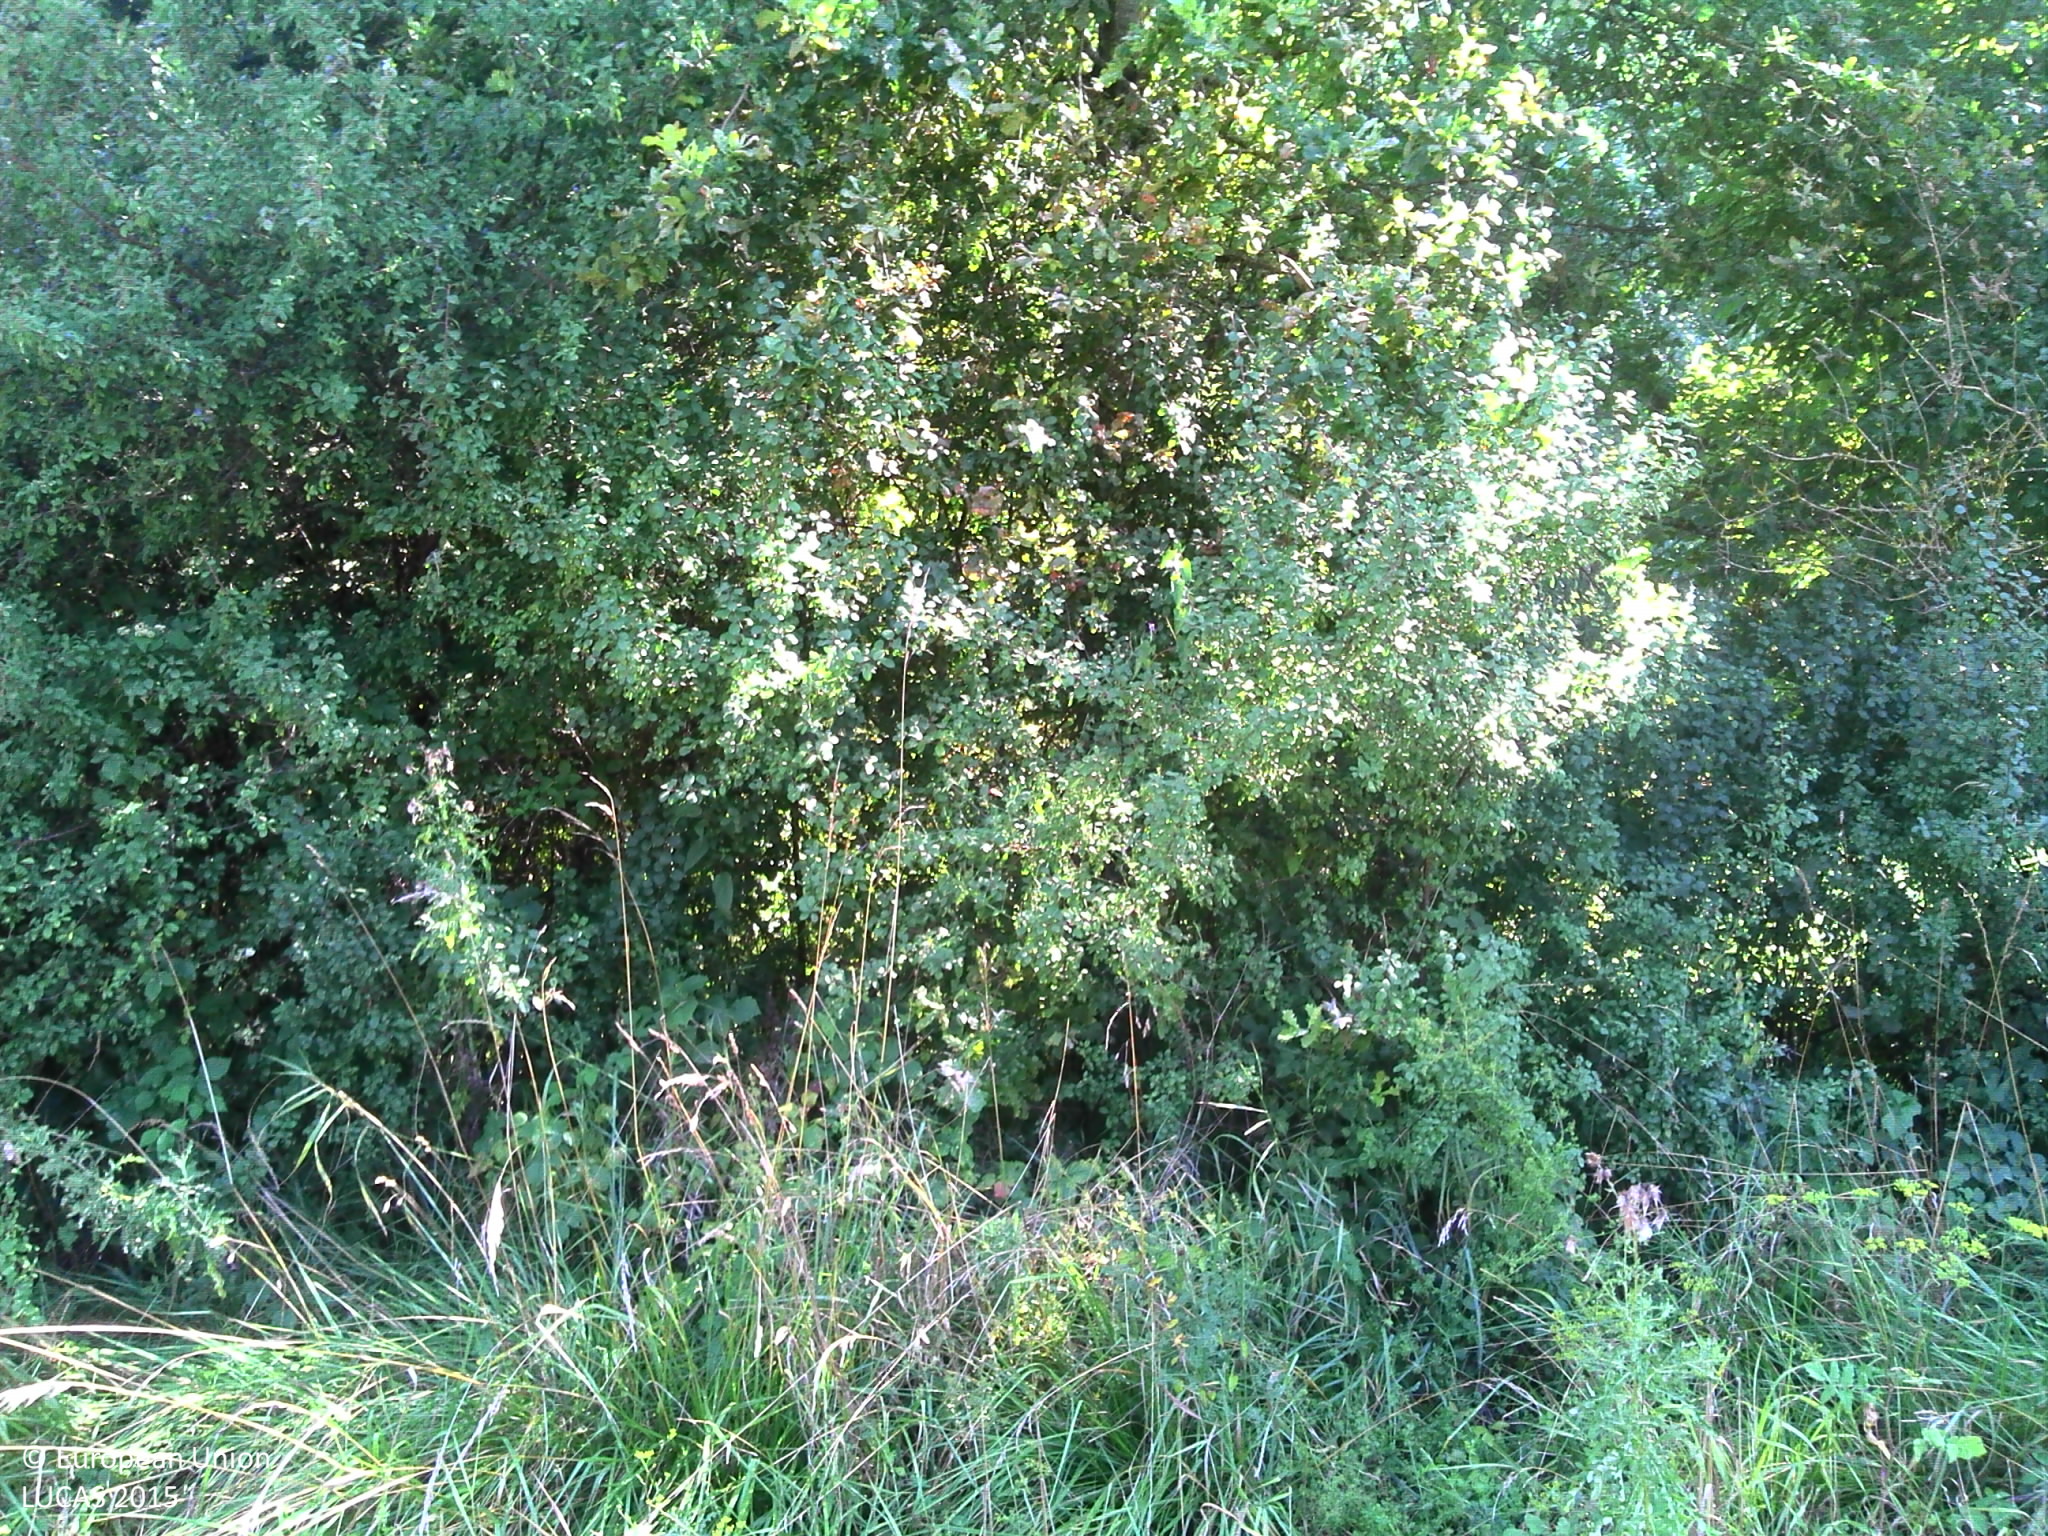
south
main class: Cropland
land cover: Common wheat
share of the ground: 10 - 25 %
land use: Agriculture (excluding fallow land and kitchen gardens)
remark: Harvested field
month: August
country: FR
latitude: 45.2988
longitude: 0.7700
